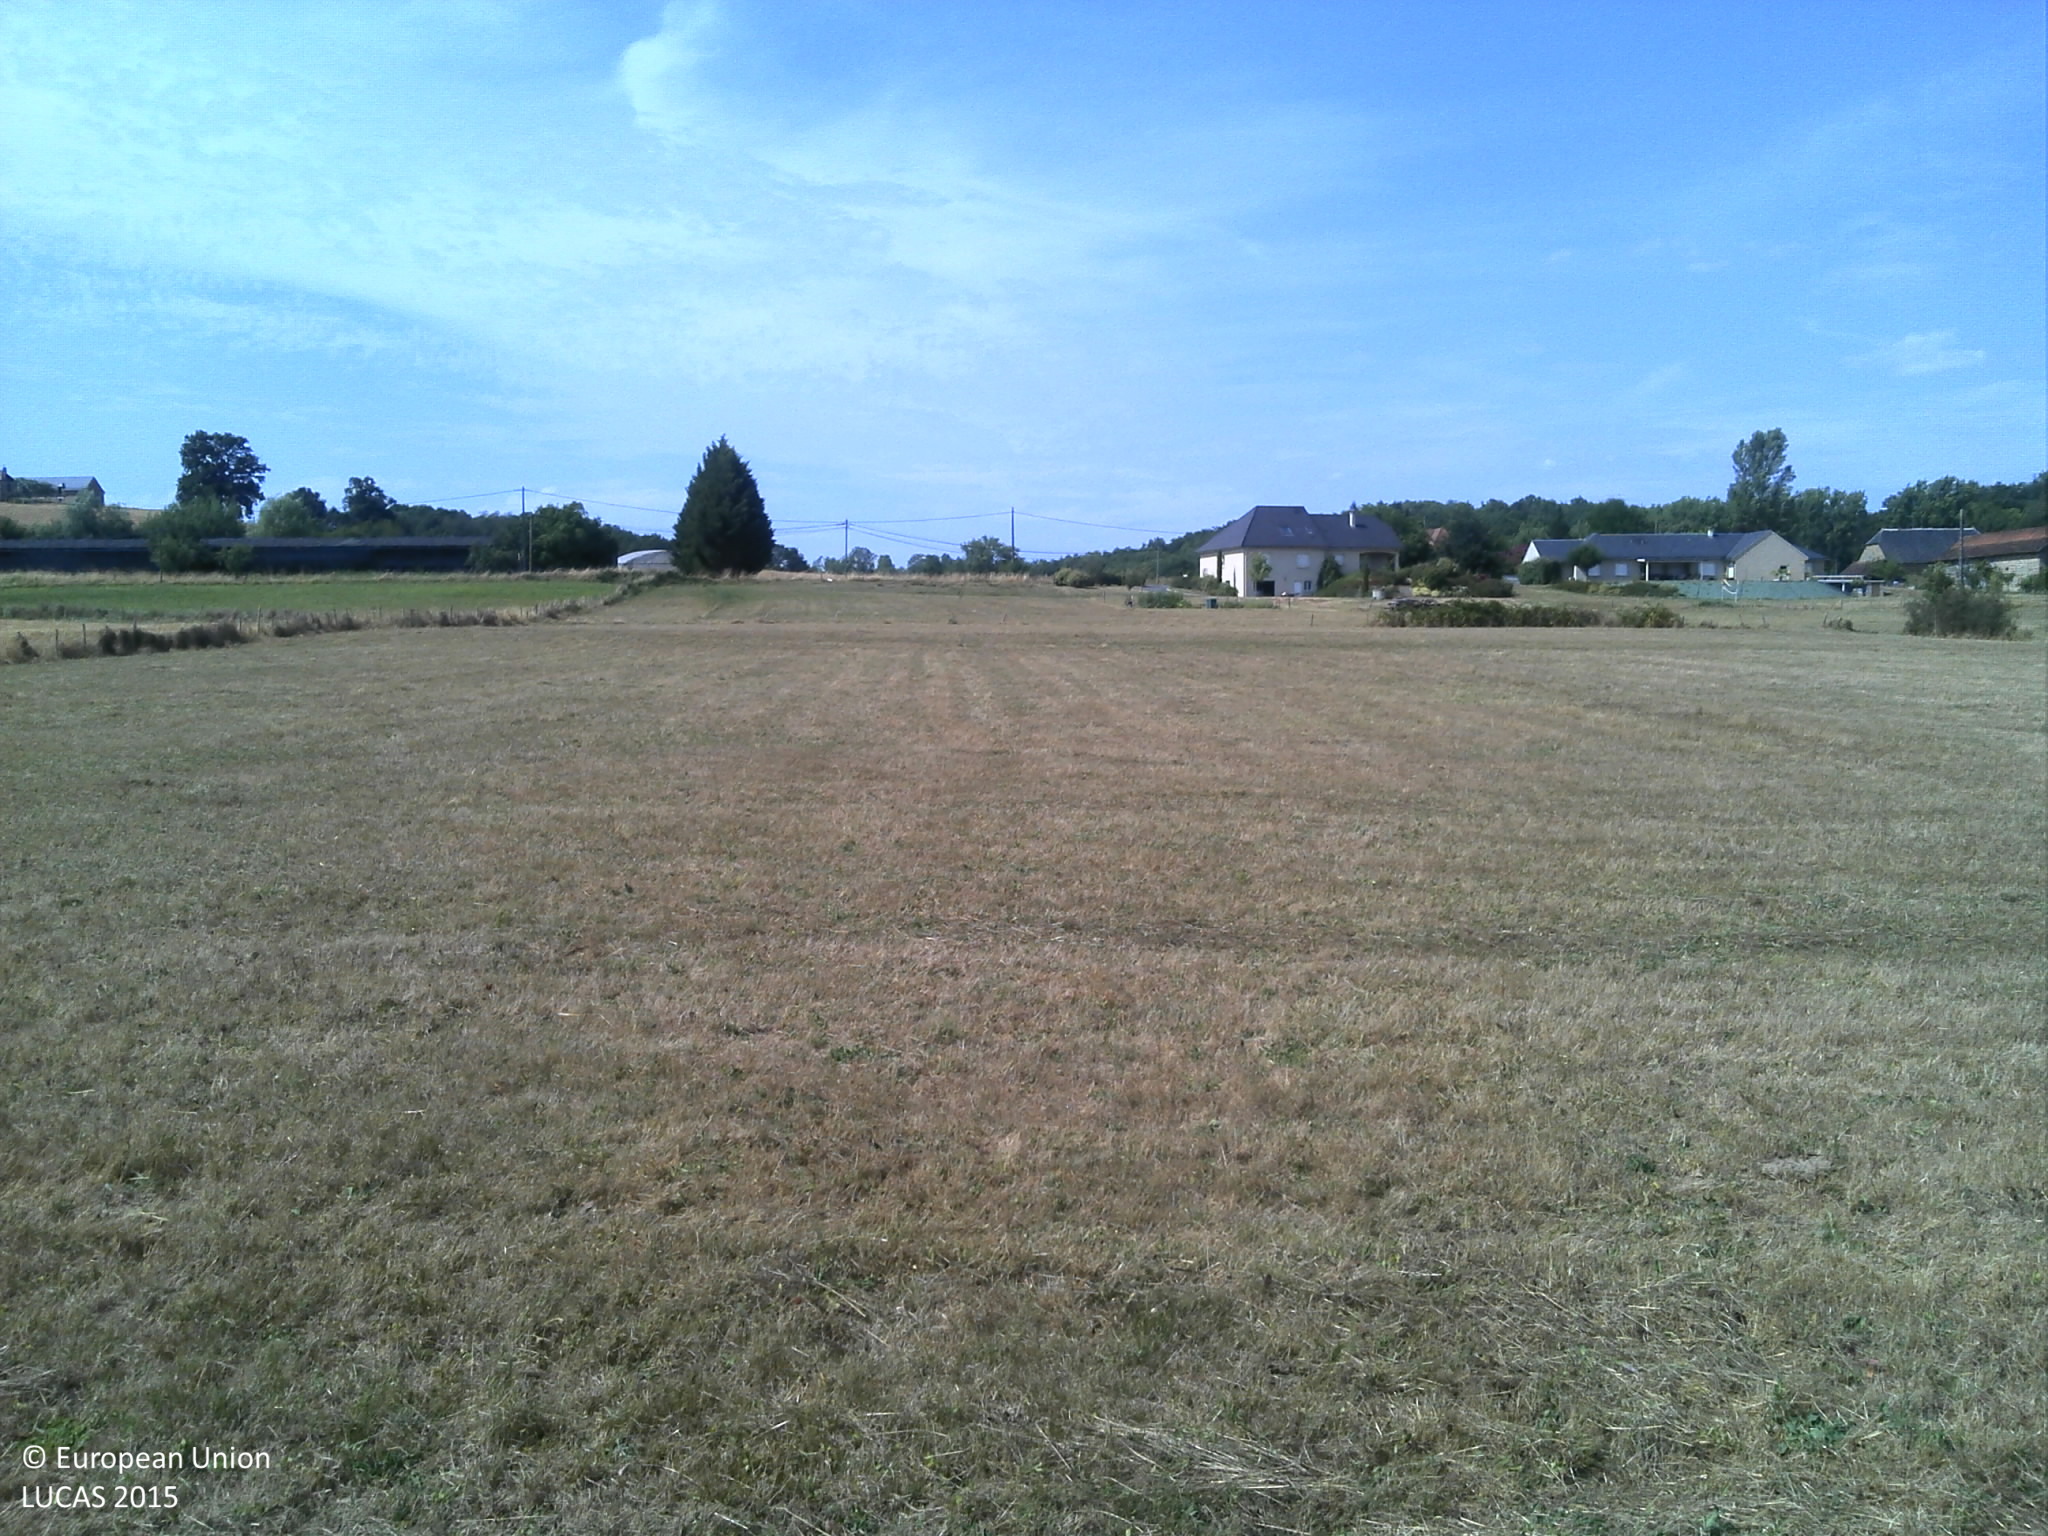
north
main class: Grassland
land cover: Grassland without tree/shrub cover
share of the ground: > 75 %
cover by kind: herbaceous plants 100 %
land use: Agriculture (excluding fallow land and kitchen gardens)
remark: Harvested field
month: July
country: FR
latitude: 45.1358
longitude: 1.4115
